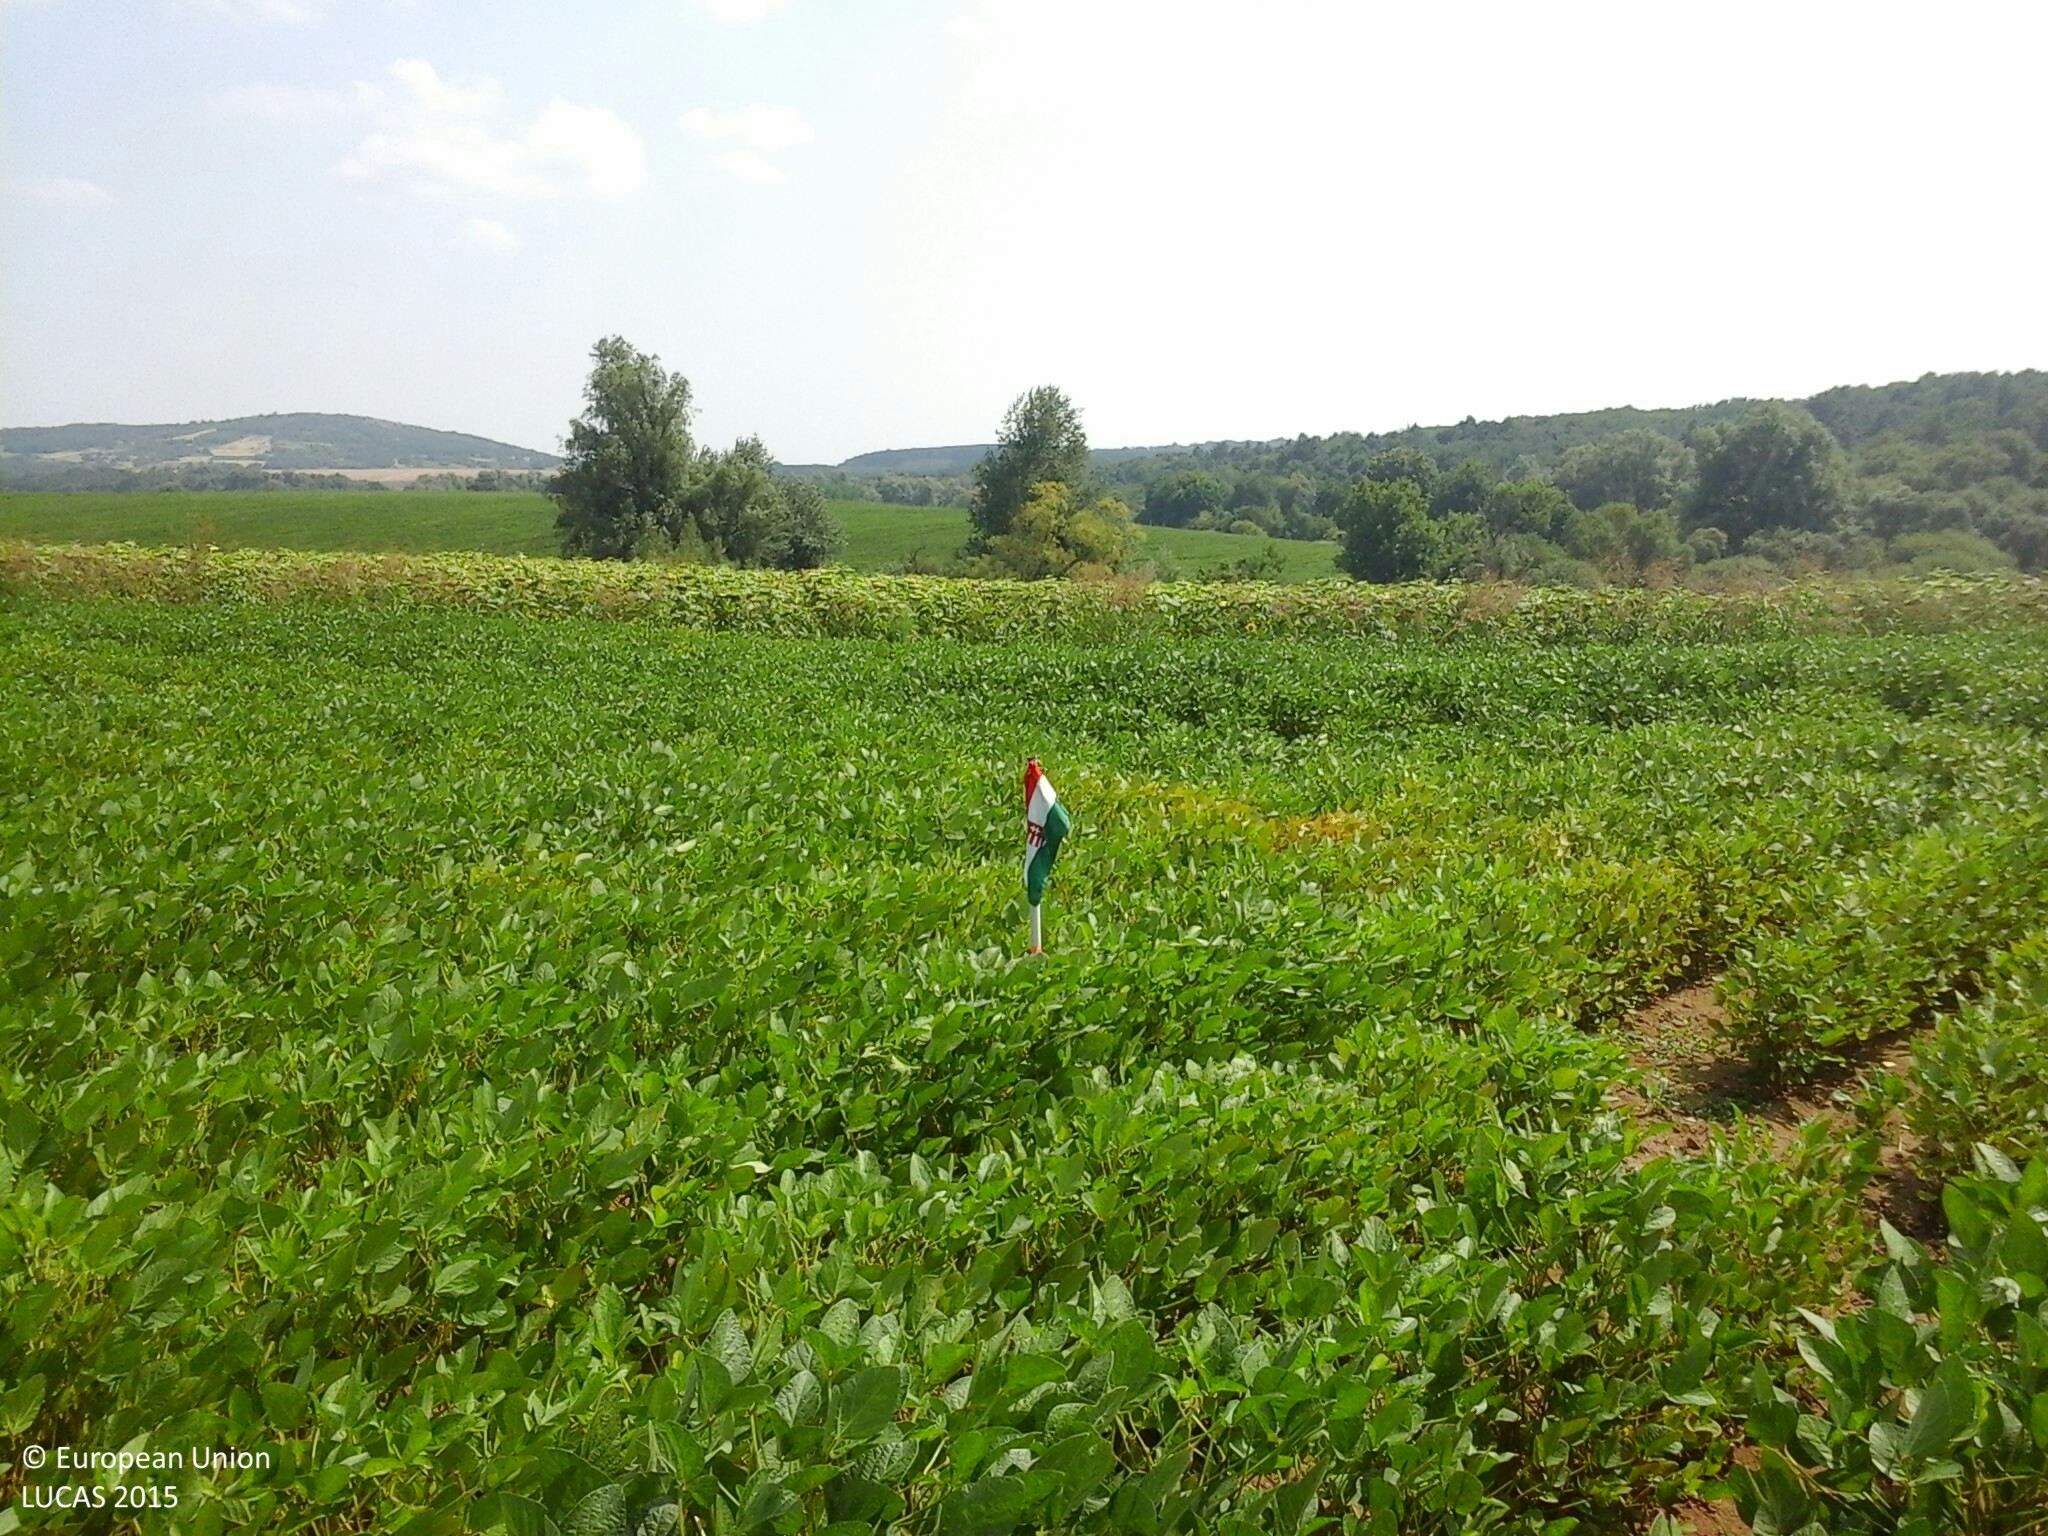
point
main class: Cropland
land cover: Soya
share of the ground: > 75 %
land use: Agriculture (excluding fallow land and kitchen gardens)
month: August
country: HU
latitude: 45.9099
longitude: 18.1924
